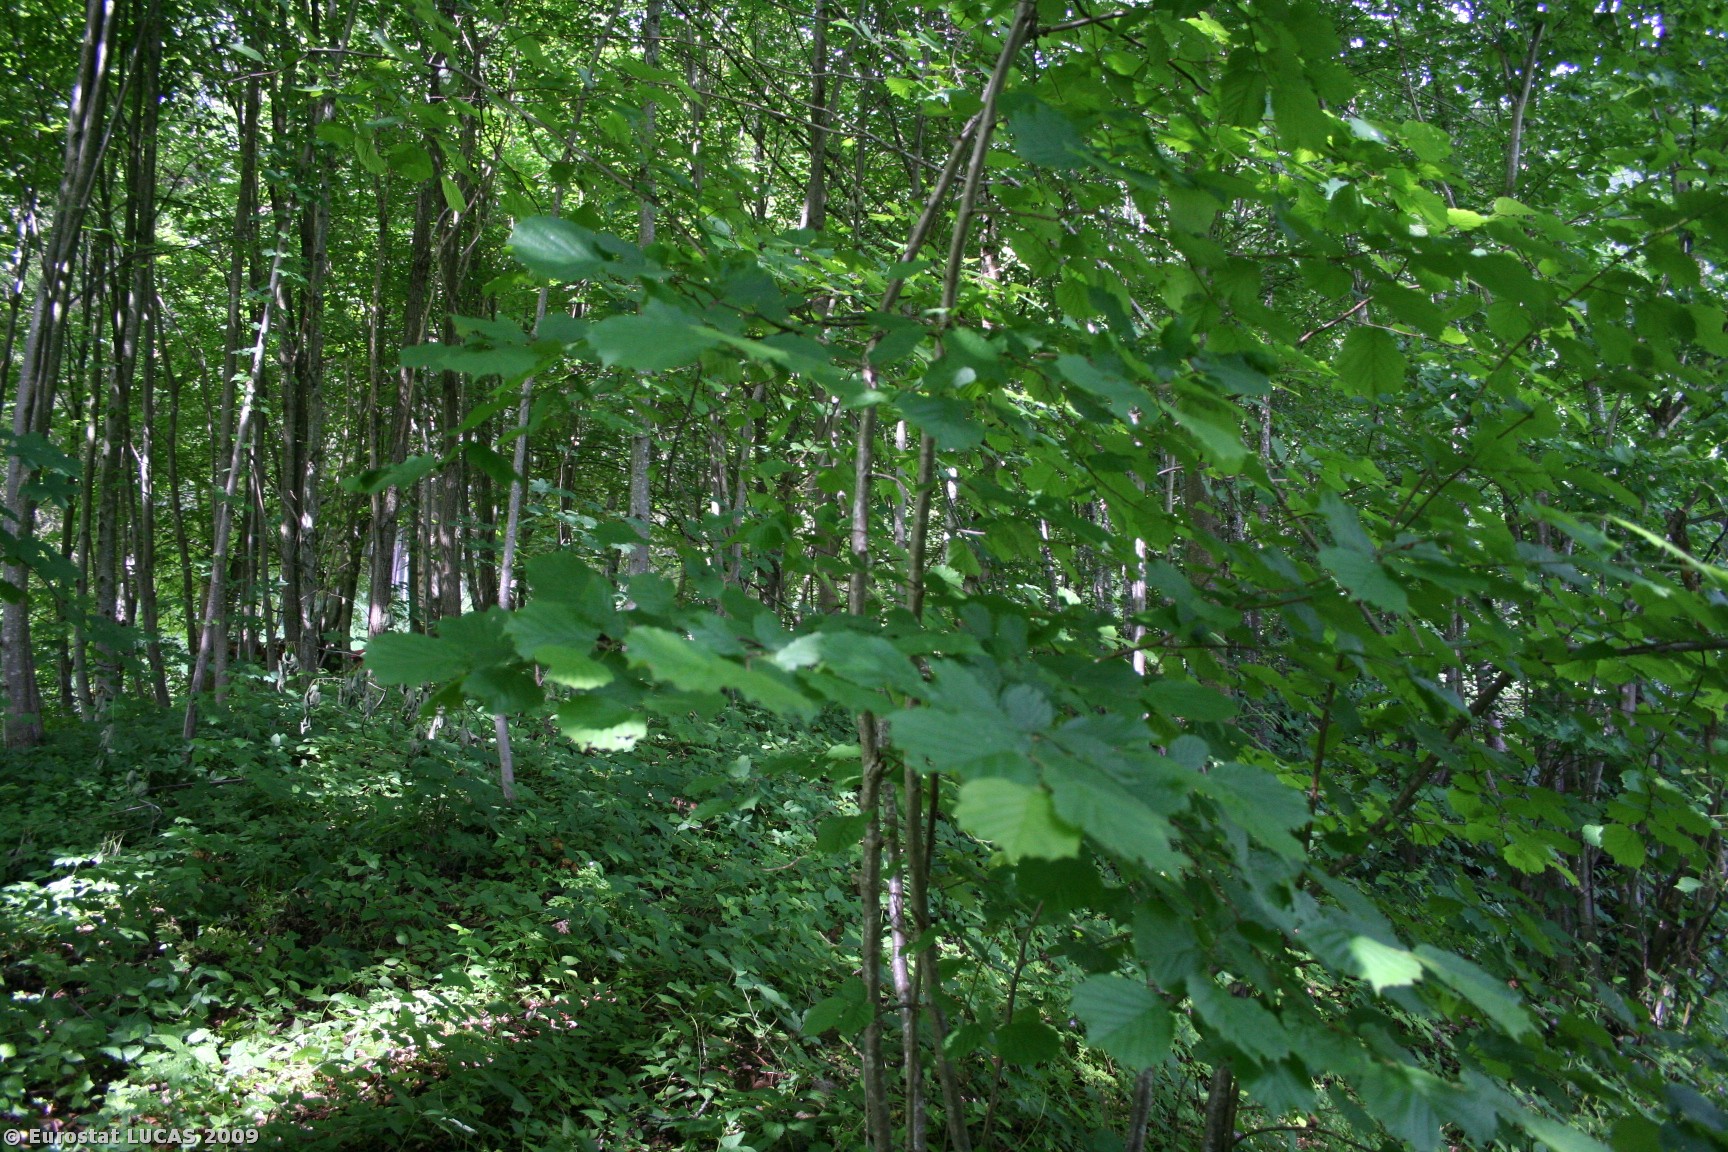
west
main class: Woodland
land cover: Broadleaved woodland
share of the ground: > 75 %
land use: Forestry
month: June
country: AT
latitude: 47.2176
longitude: 11.8602
